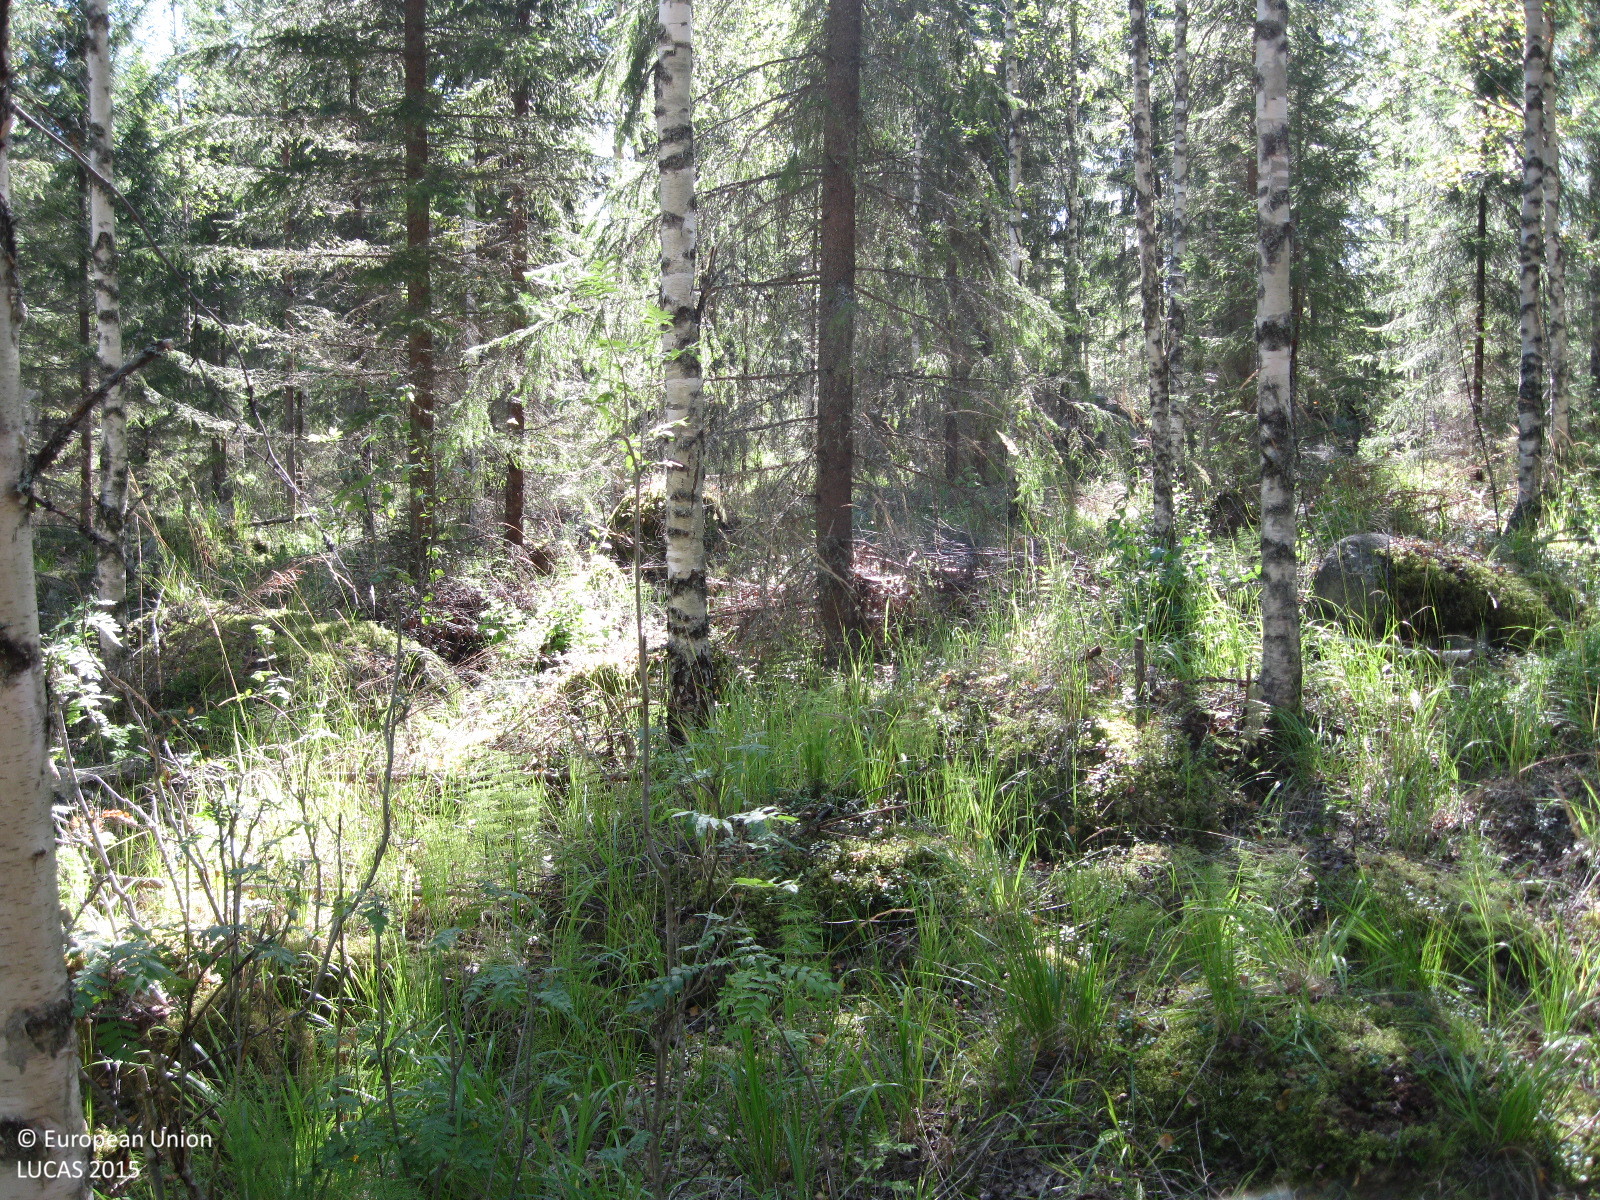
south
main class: Woodland
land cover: Spruce dominated mixed woodland
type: boreal forest
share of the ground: 50 - 75 %
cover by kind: broadleaved forest trees 40 %, coniferous forest trees 25 %, herbaceous plants 20 %, lichens and mosses 15 %
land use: Forestry
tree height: > 5 m
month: August
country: FI
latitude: 61.2645
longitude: 25.0098
